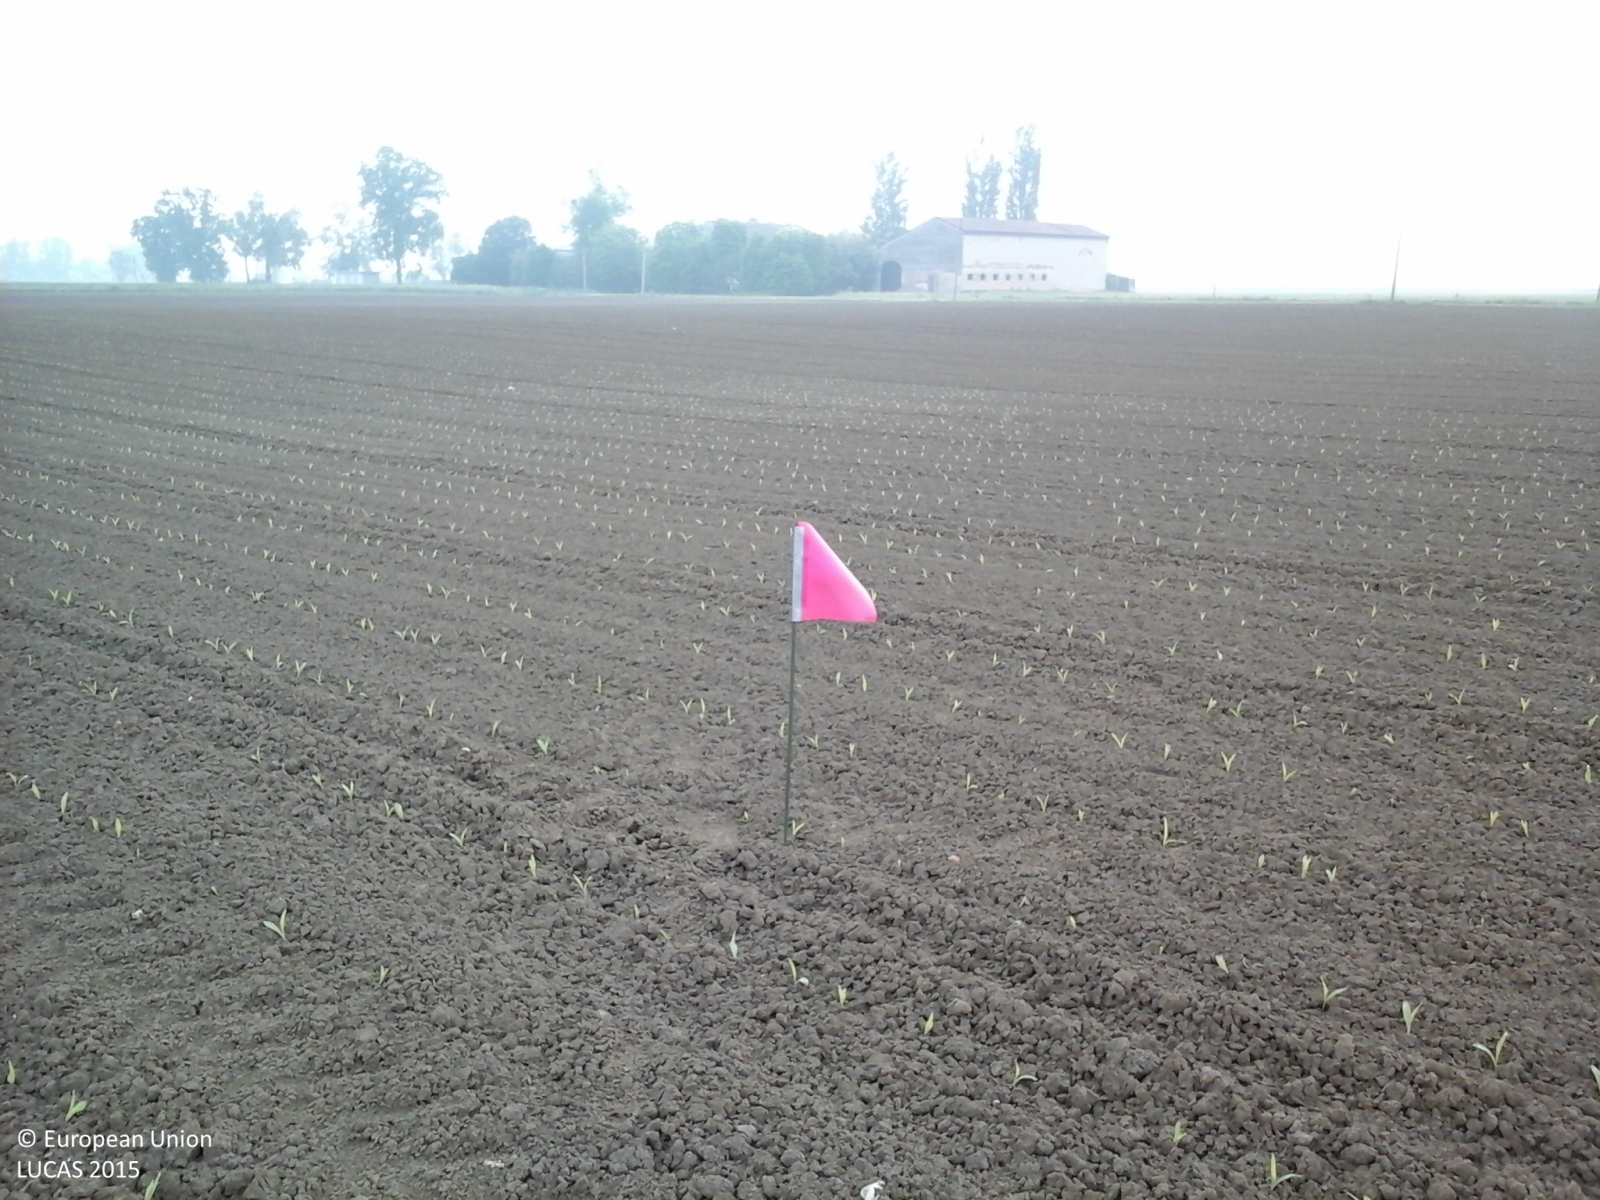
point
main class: Cropland
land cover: Maize
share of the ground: < 10 %
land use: Agriculture (excluding fallow land and kitchen gardens)
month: May
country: IT
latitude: 45.0530
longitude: 10.4182
